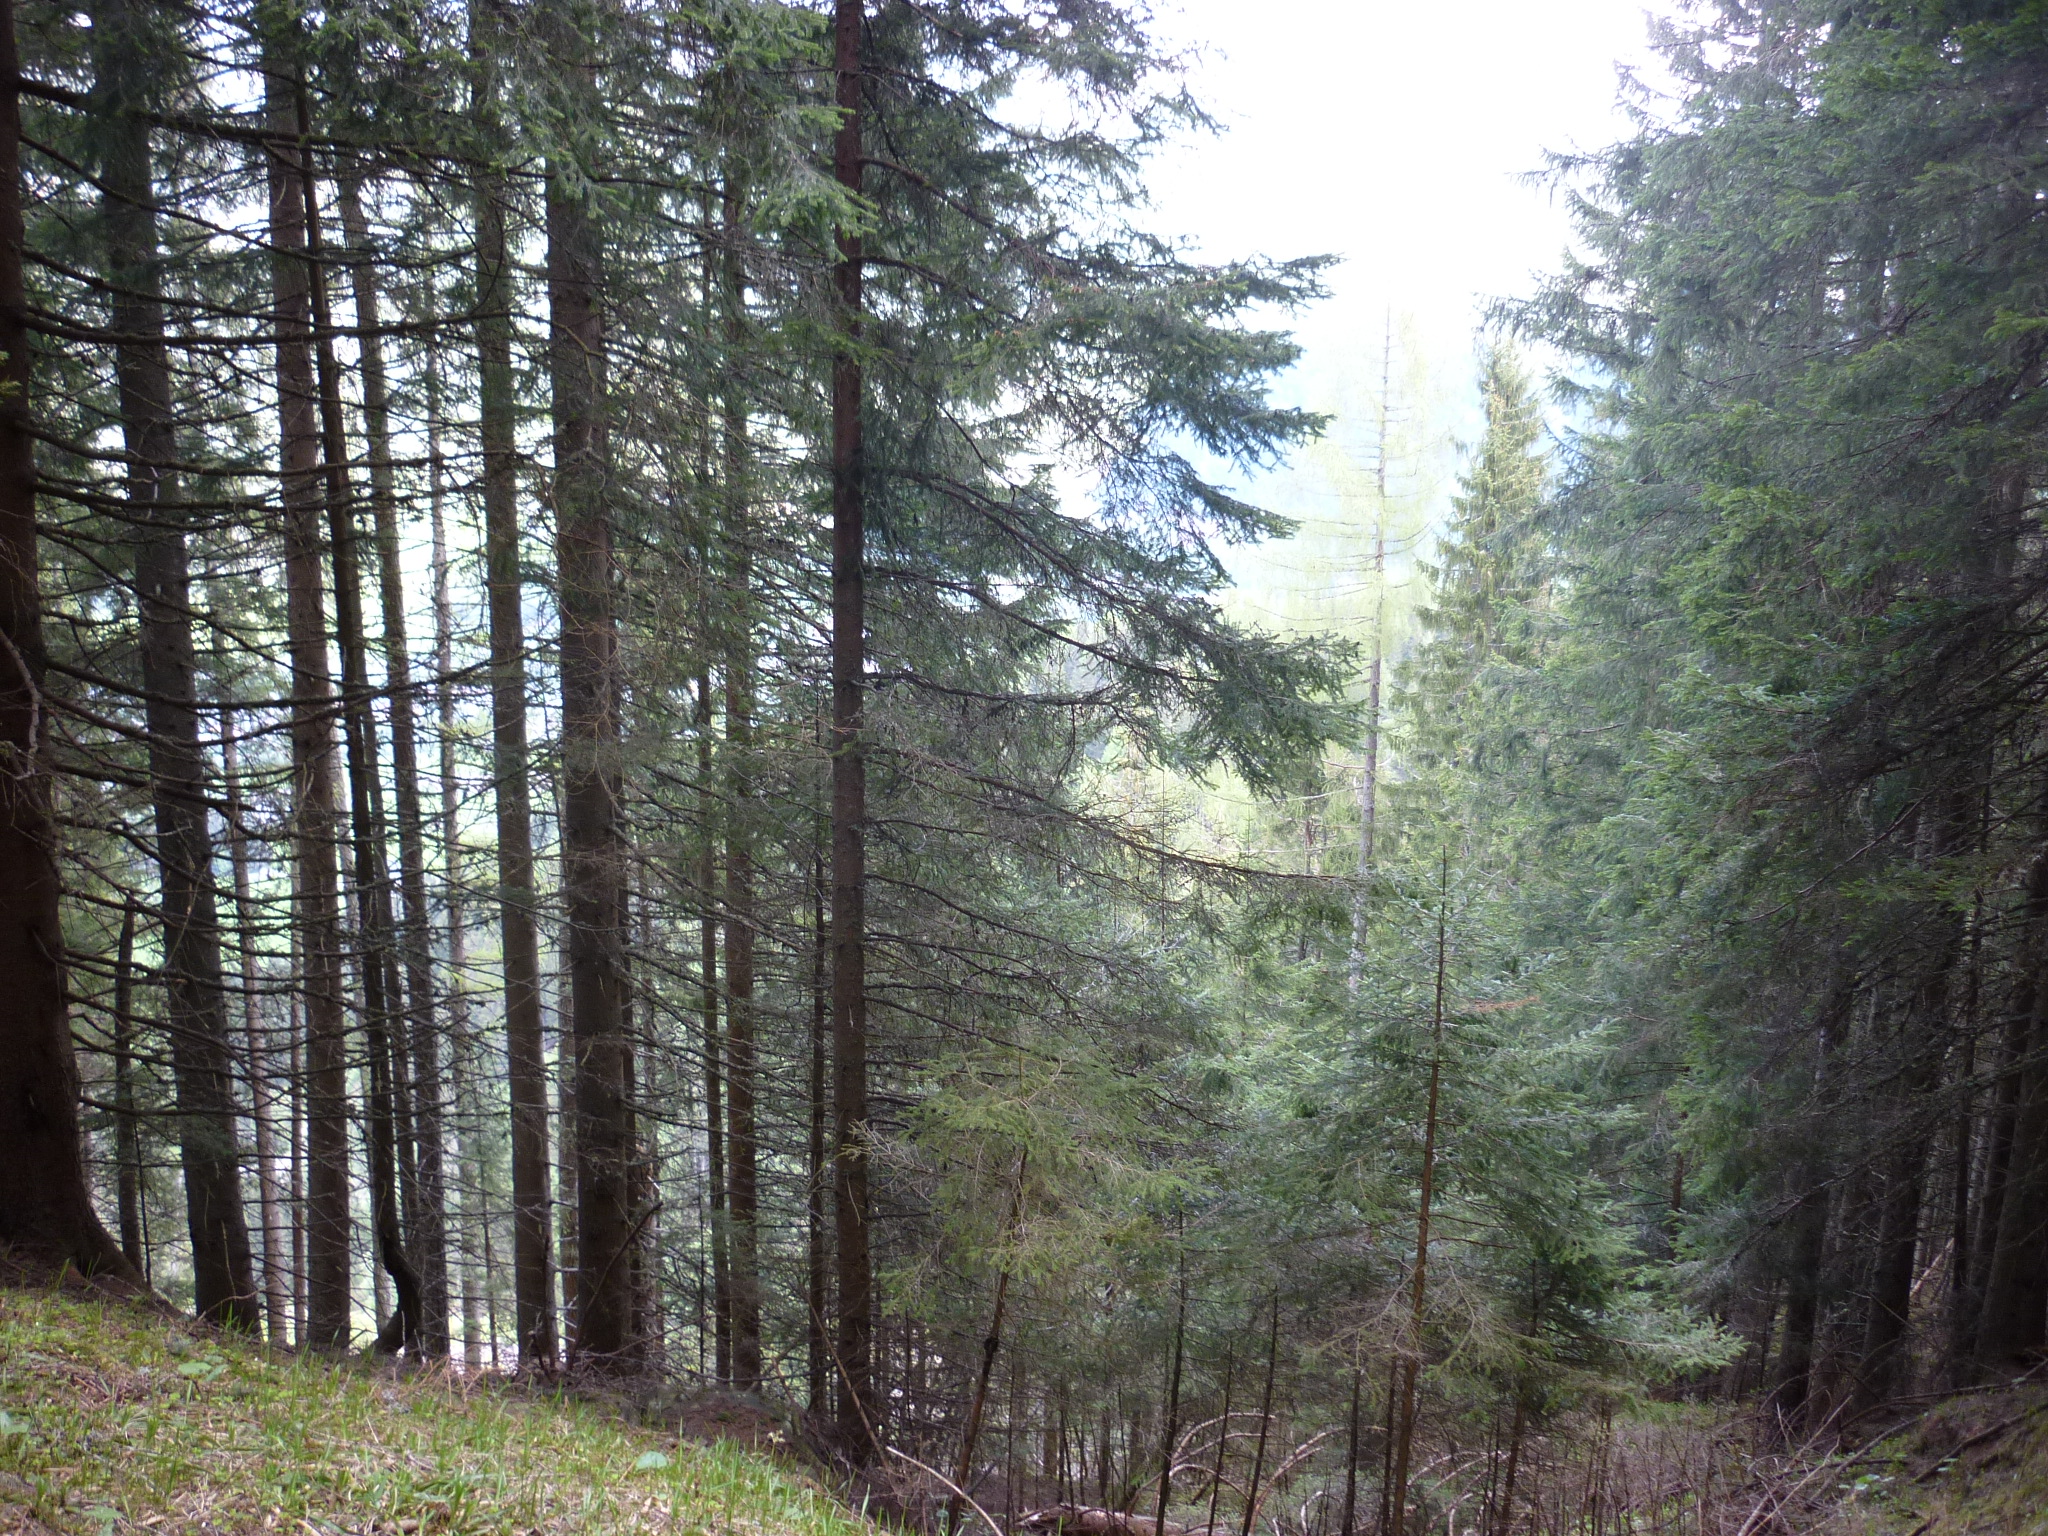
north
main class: Grassland
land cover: Grassland with sparse tree/shrub cover
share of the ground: > 75 %
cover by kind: herbaceous plants 90 %, coniferous forest trees 5 %, lichens and mosses 5 %
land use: Forestry
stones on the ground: 10 - 25 %
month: May
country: AT
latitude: 47.5062
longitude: 14.3671
